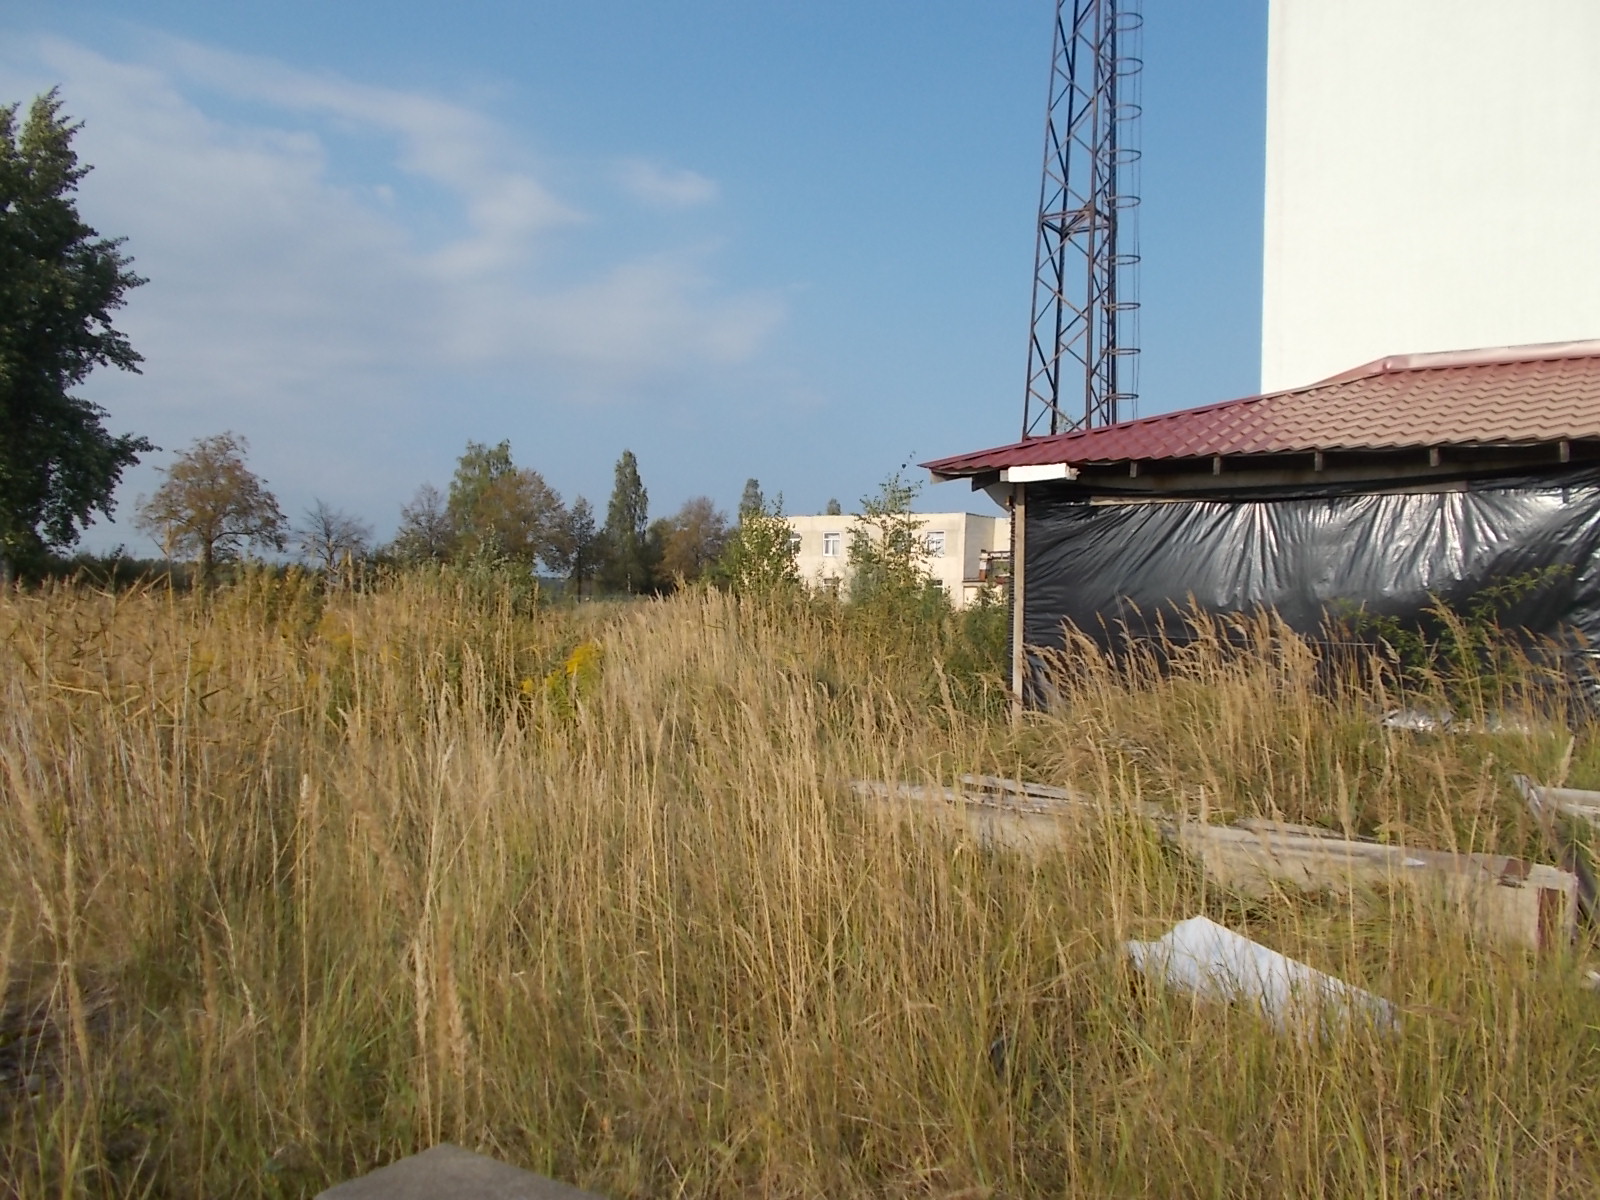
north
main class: Grassland
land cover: Spontaneously vegetated surfaces
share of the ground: 25 - 50 %
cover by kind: herbaceous plants 35 %
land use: Abandoned areas
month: September
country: LV
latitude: 56.9387
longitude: 23.6016
